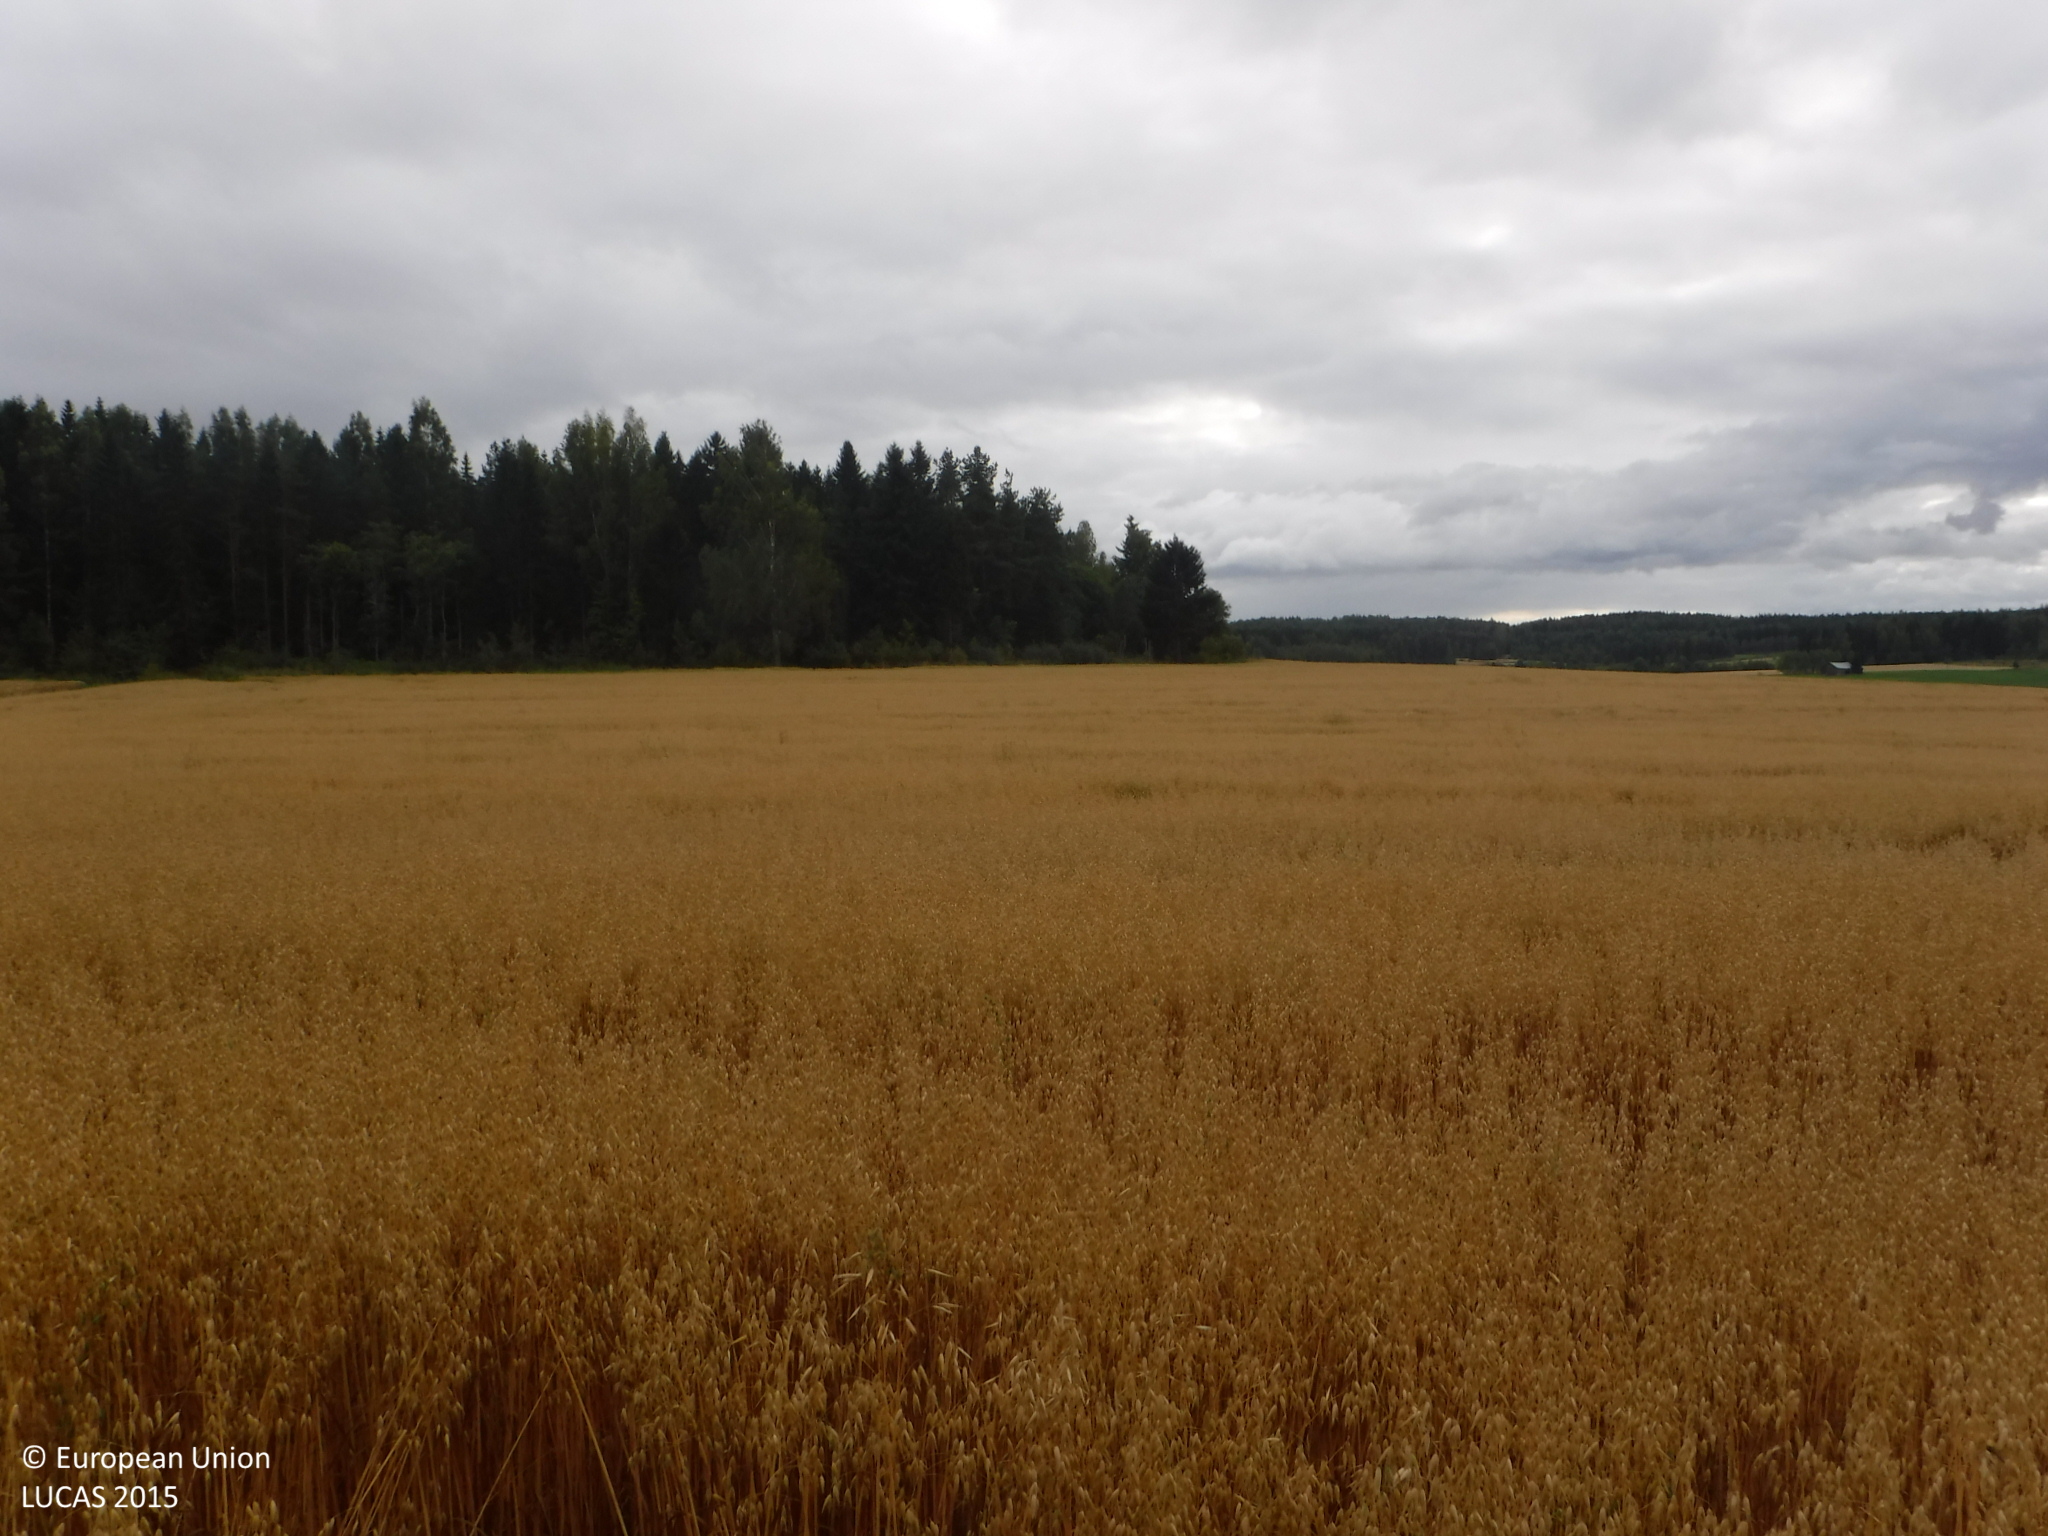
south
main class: Cropland
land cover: Oats
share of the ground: > 75 %
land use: Agriculture (excluding fallow land and kitchen gardens)
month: September
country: FI
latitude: 61.3794
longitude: 23.0797
